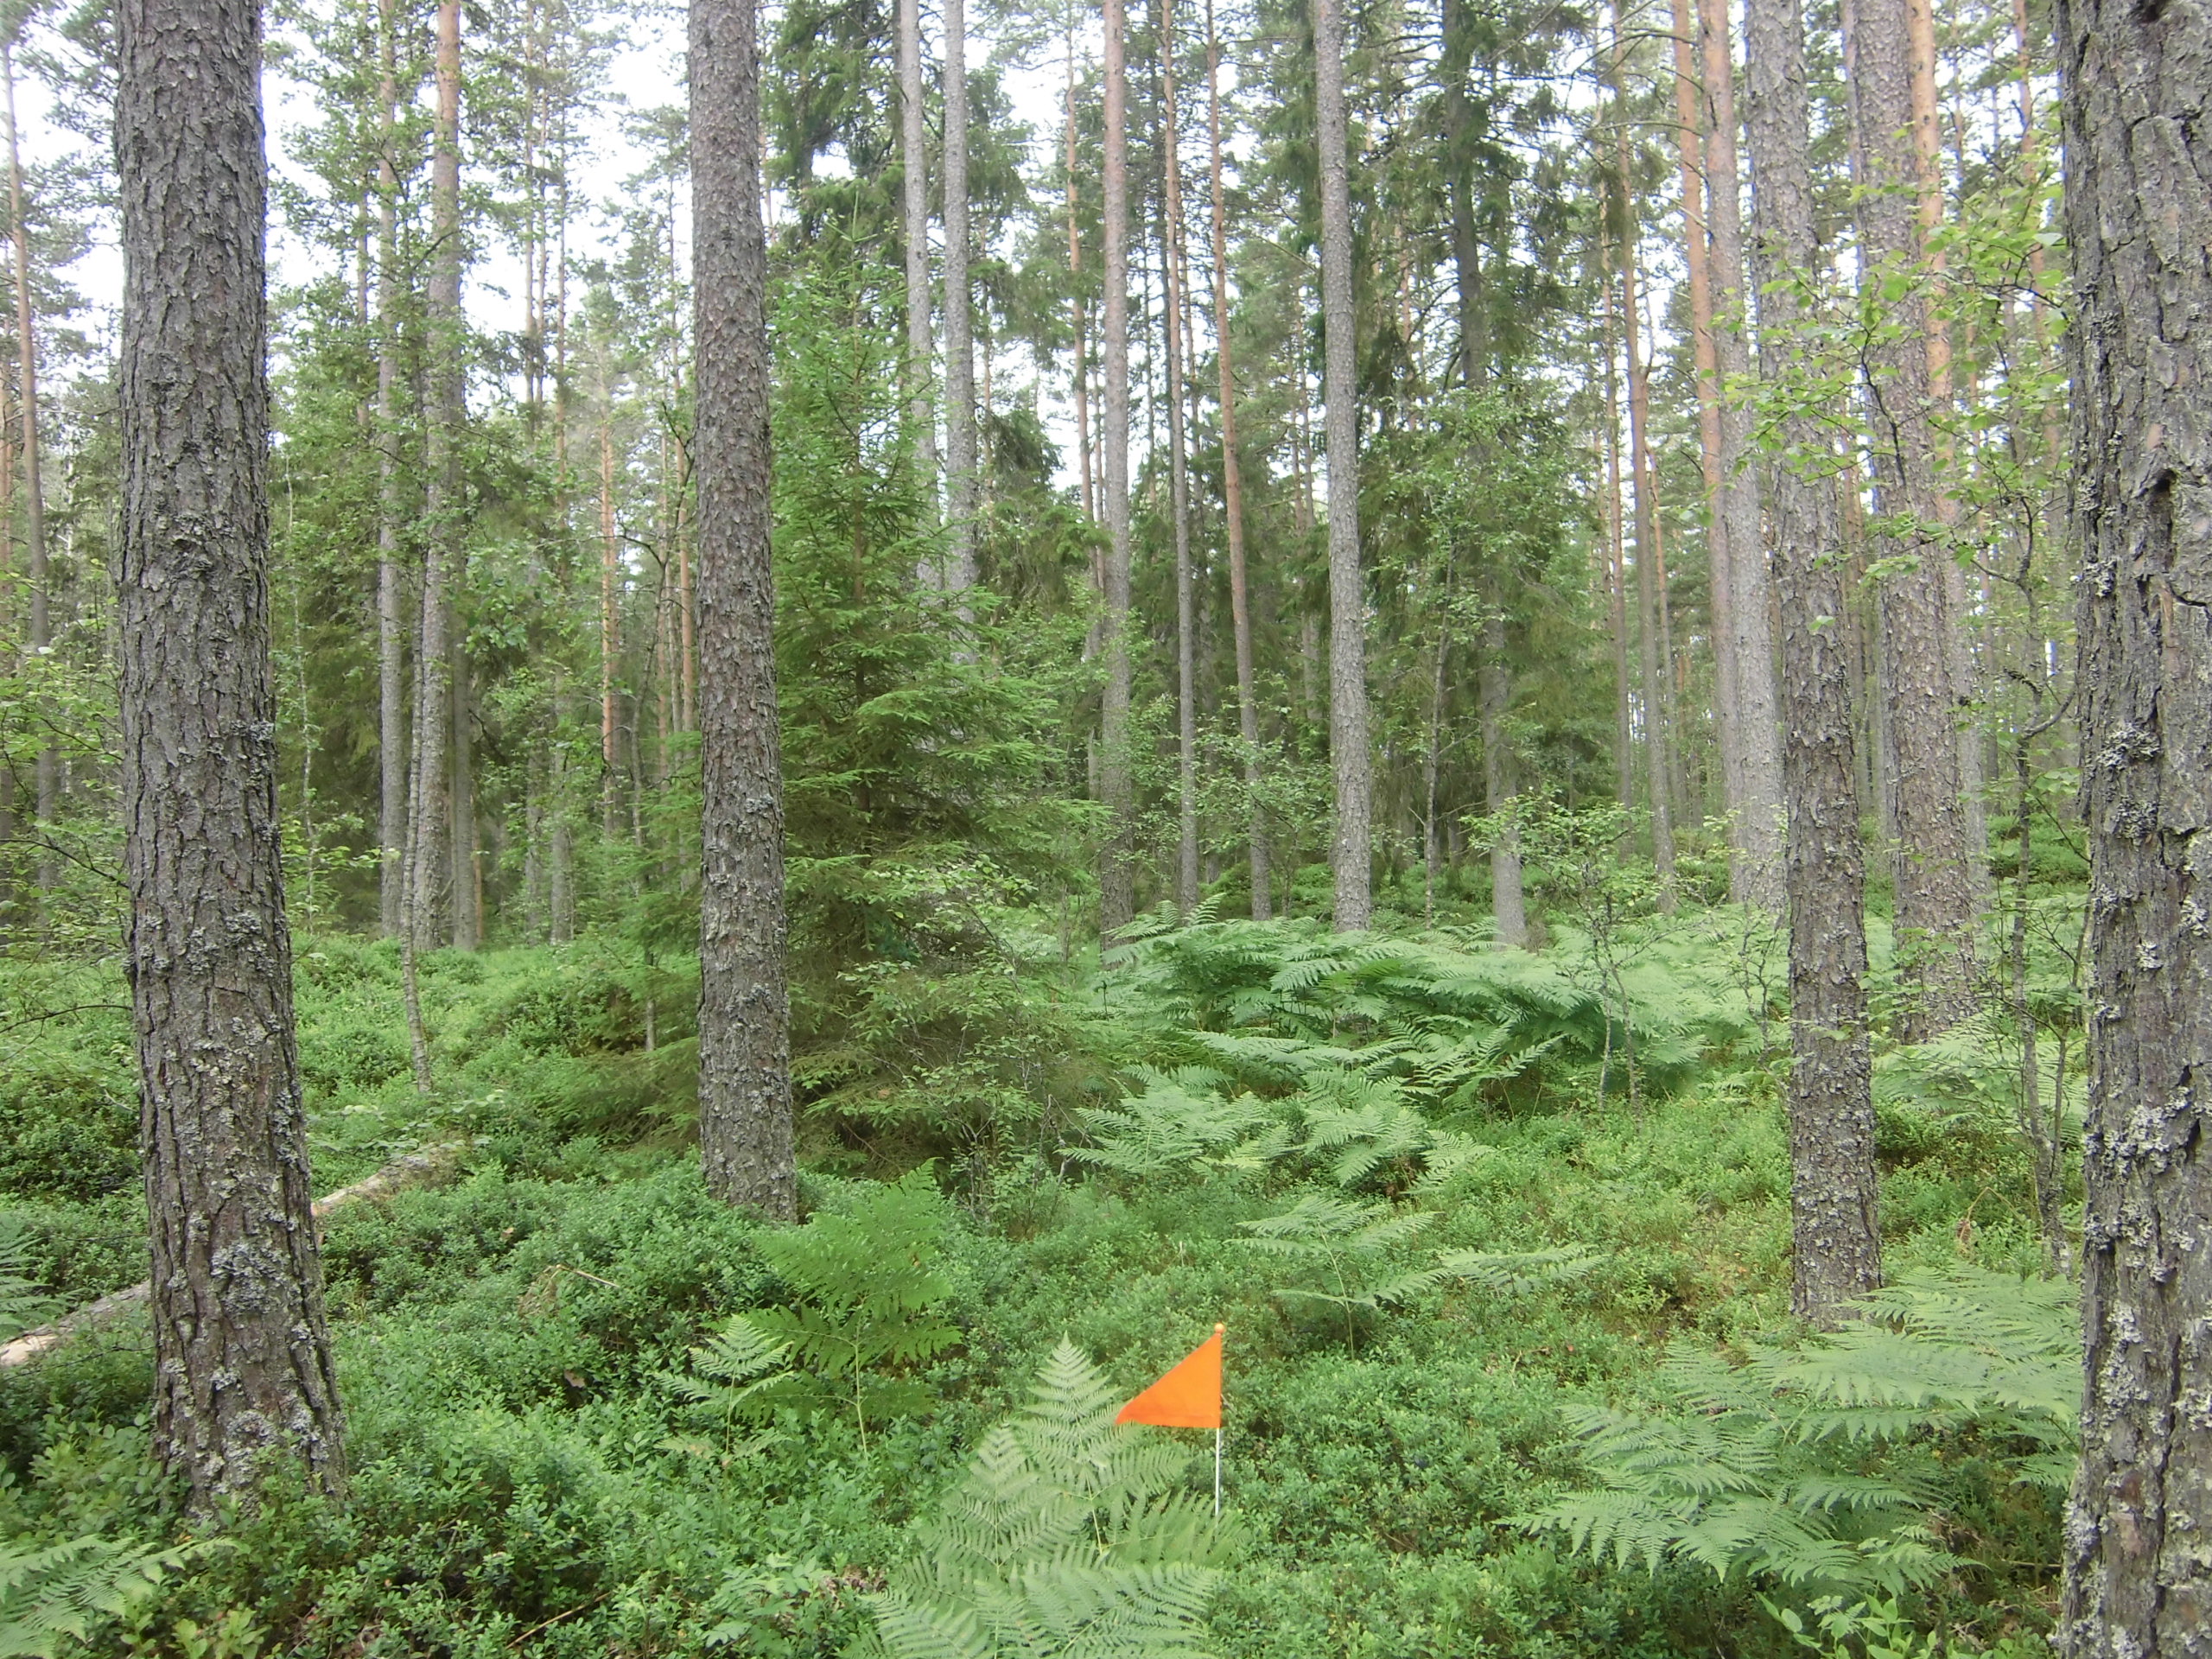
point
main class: Woodland
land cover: Pine dominated coniferous woodland
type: boreal forest
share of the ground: 50 - 75 %
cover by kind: coniferous forest trees 55 %, shrubs 30 %, broadleaved forest trees 5 %, herbaceous plants 5 %, lichens and mosses 5 %
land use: Forestry
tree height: > 5 m
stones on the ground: 25 - 50 %
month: July
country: SE
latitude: 57.2696
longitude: 15.2537
